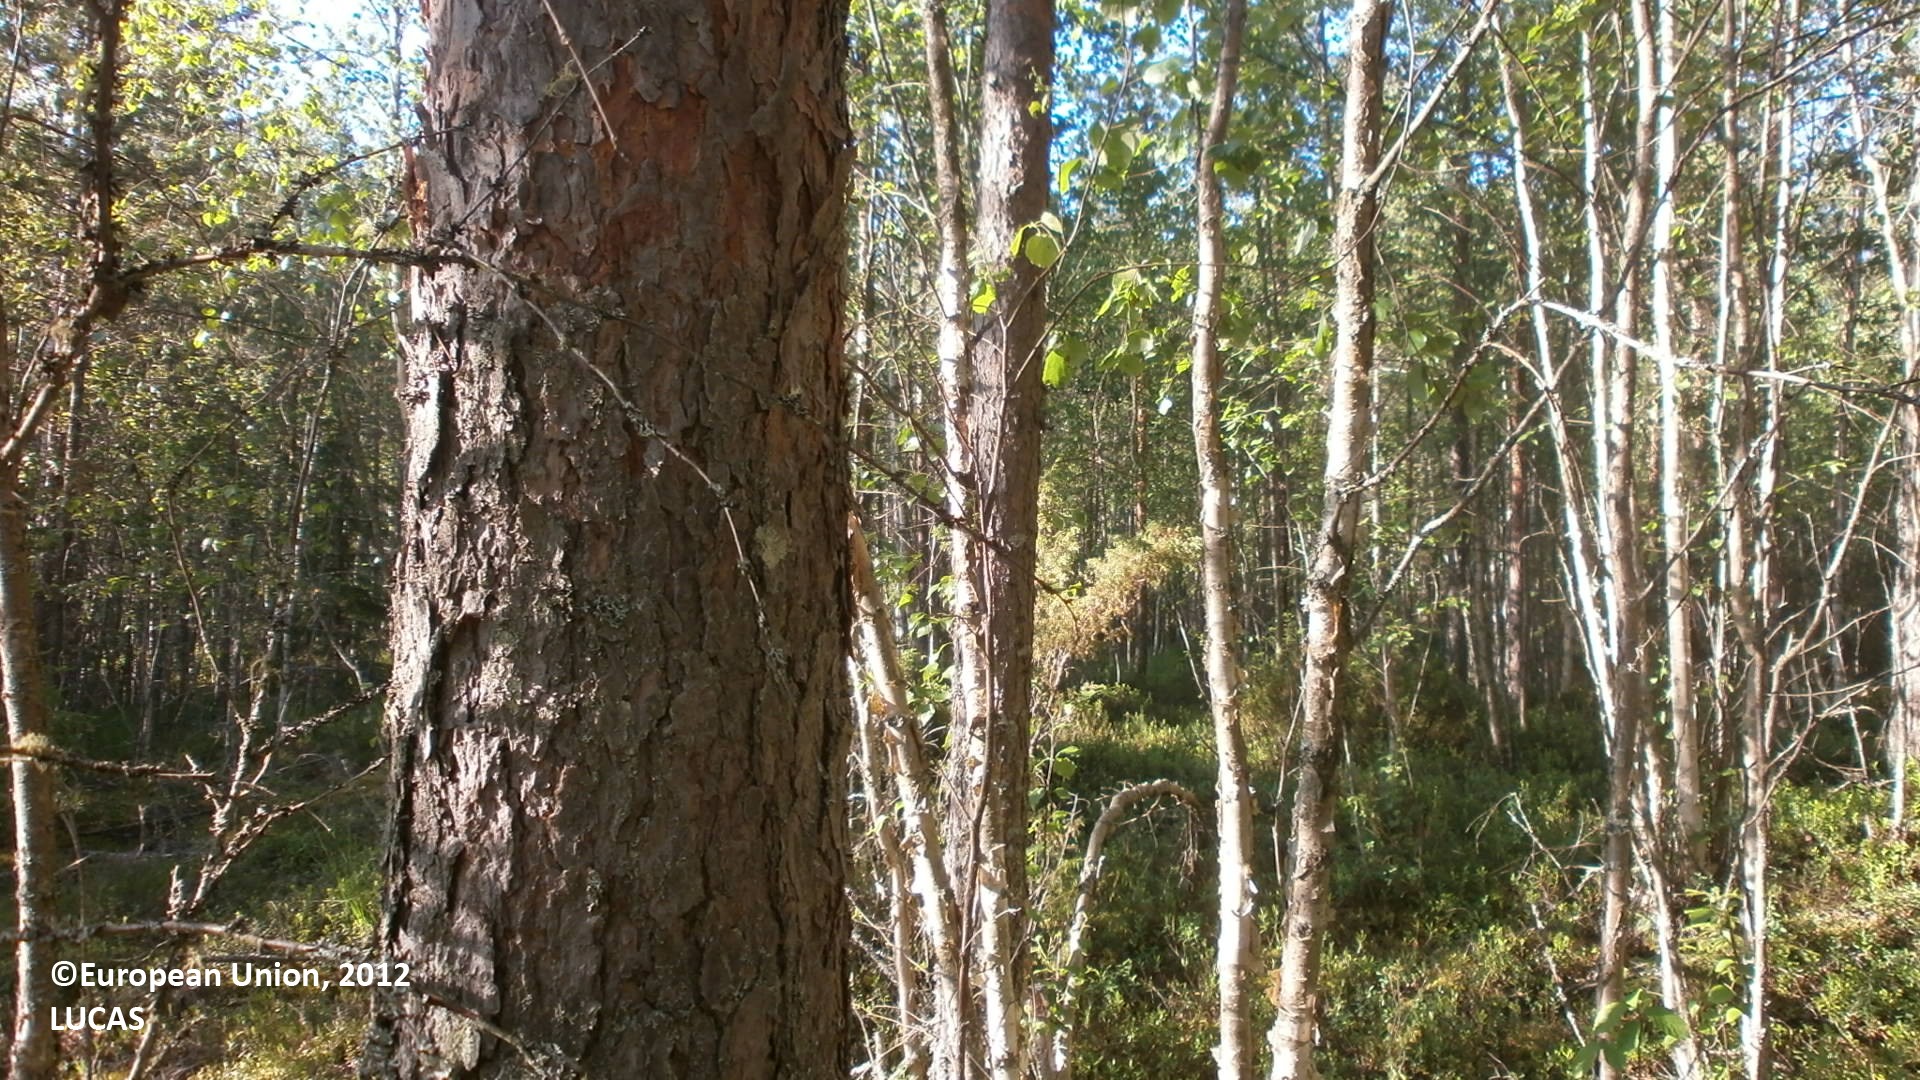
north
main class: Woodland
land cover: Pine dominated mixed woodland
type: boreal forest
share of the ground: > 75 %
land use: Forestry
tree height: > 5 m
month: July
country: FI
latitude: 64.0372
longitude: 24.9258
